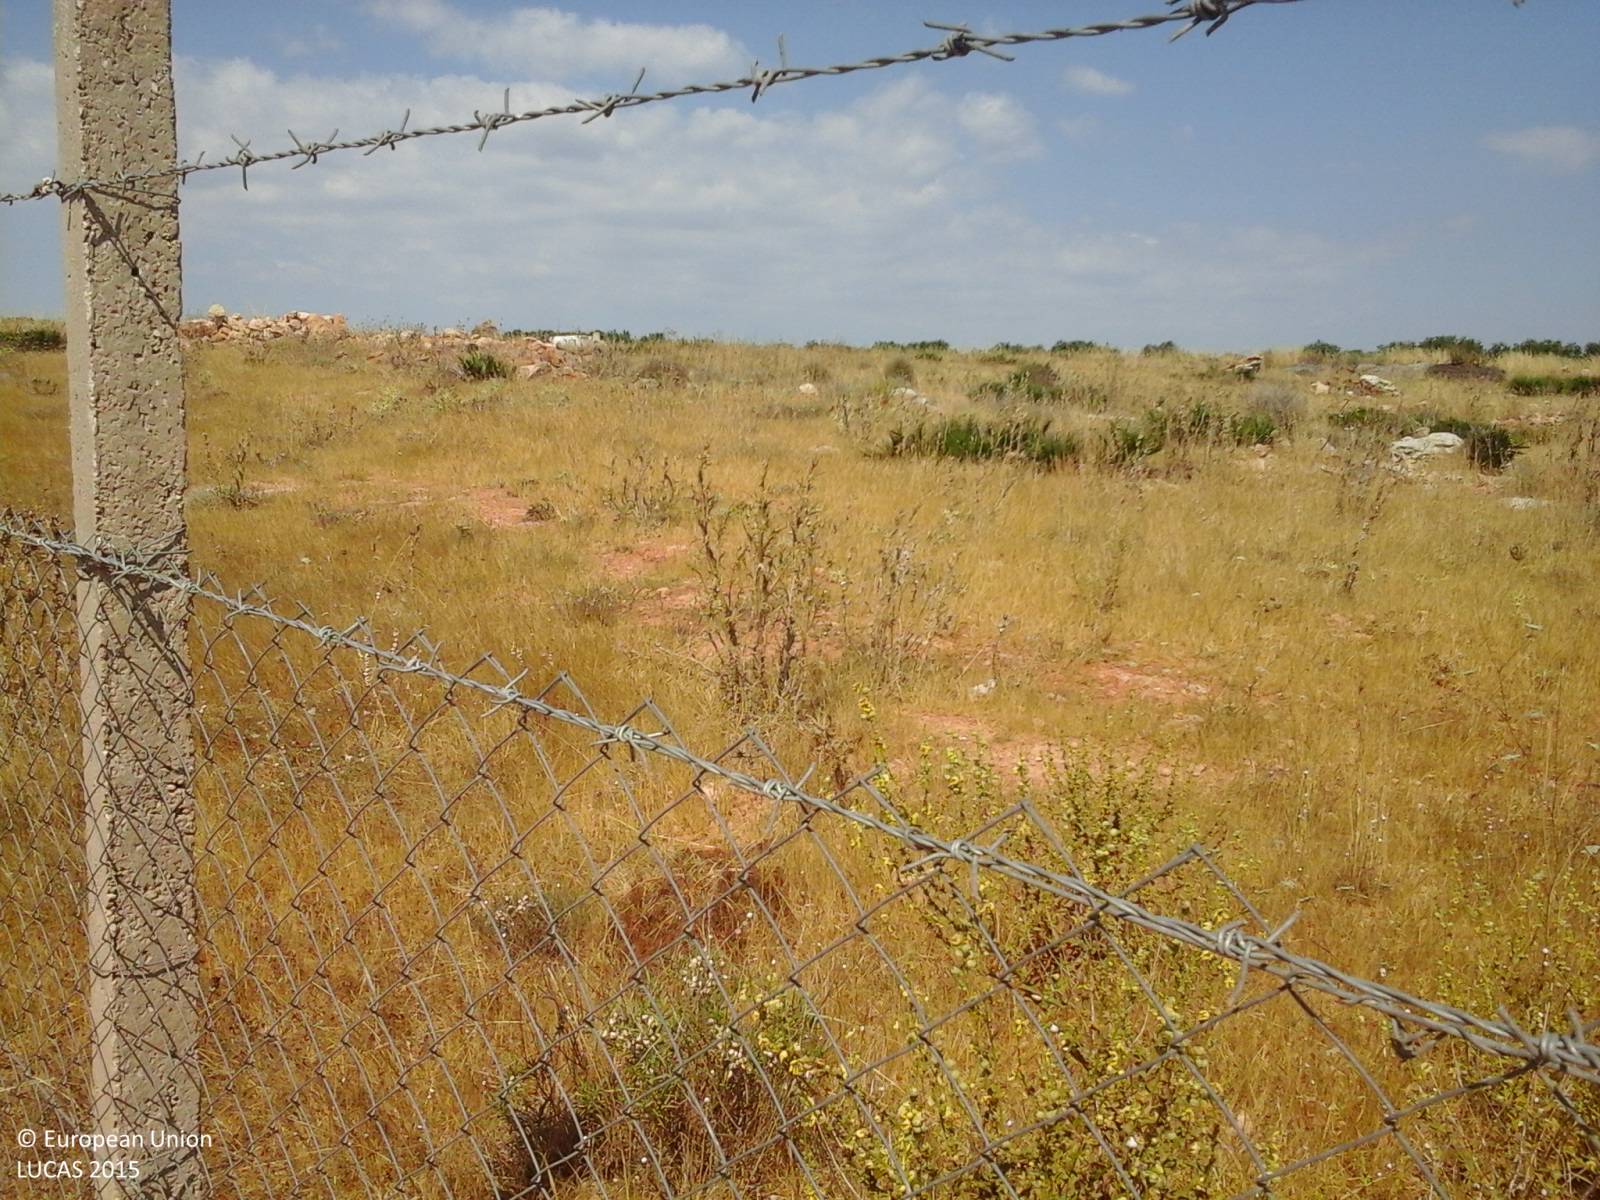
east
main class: Grassland
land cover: Grassland with sparse tree/shrub cover
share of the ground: > 75 %
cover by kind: herbaceous plants 85 %, shrubs 10 %, broadleaved forest trees 5 %
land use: Semi-natural and natural areas not in use
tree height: < 5 m
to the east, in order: Grassland with sparse tree/shrub cover; Other fresh vegetables; Olive groves; Other citrus fruit; Olive groves
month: July
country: IT
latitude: 37.7302
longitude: 12.6014
